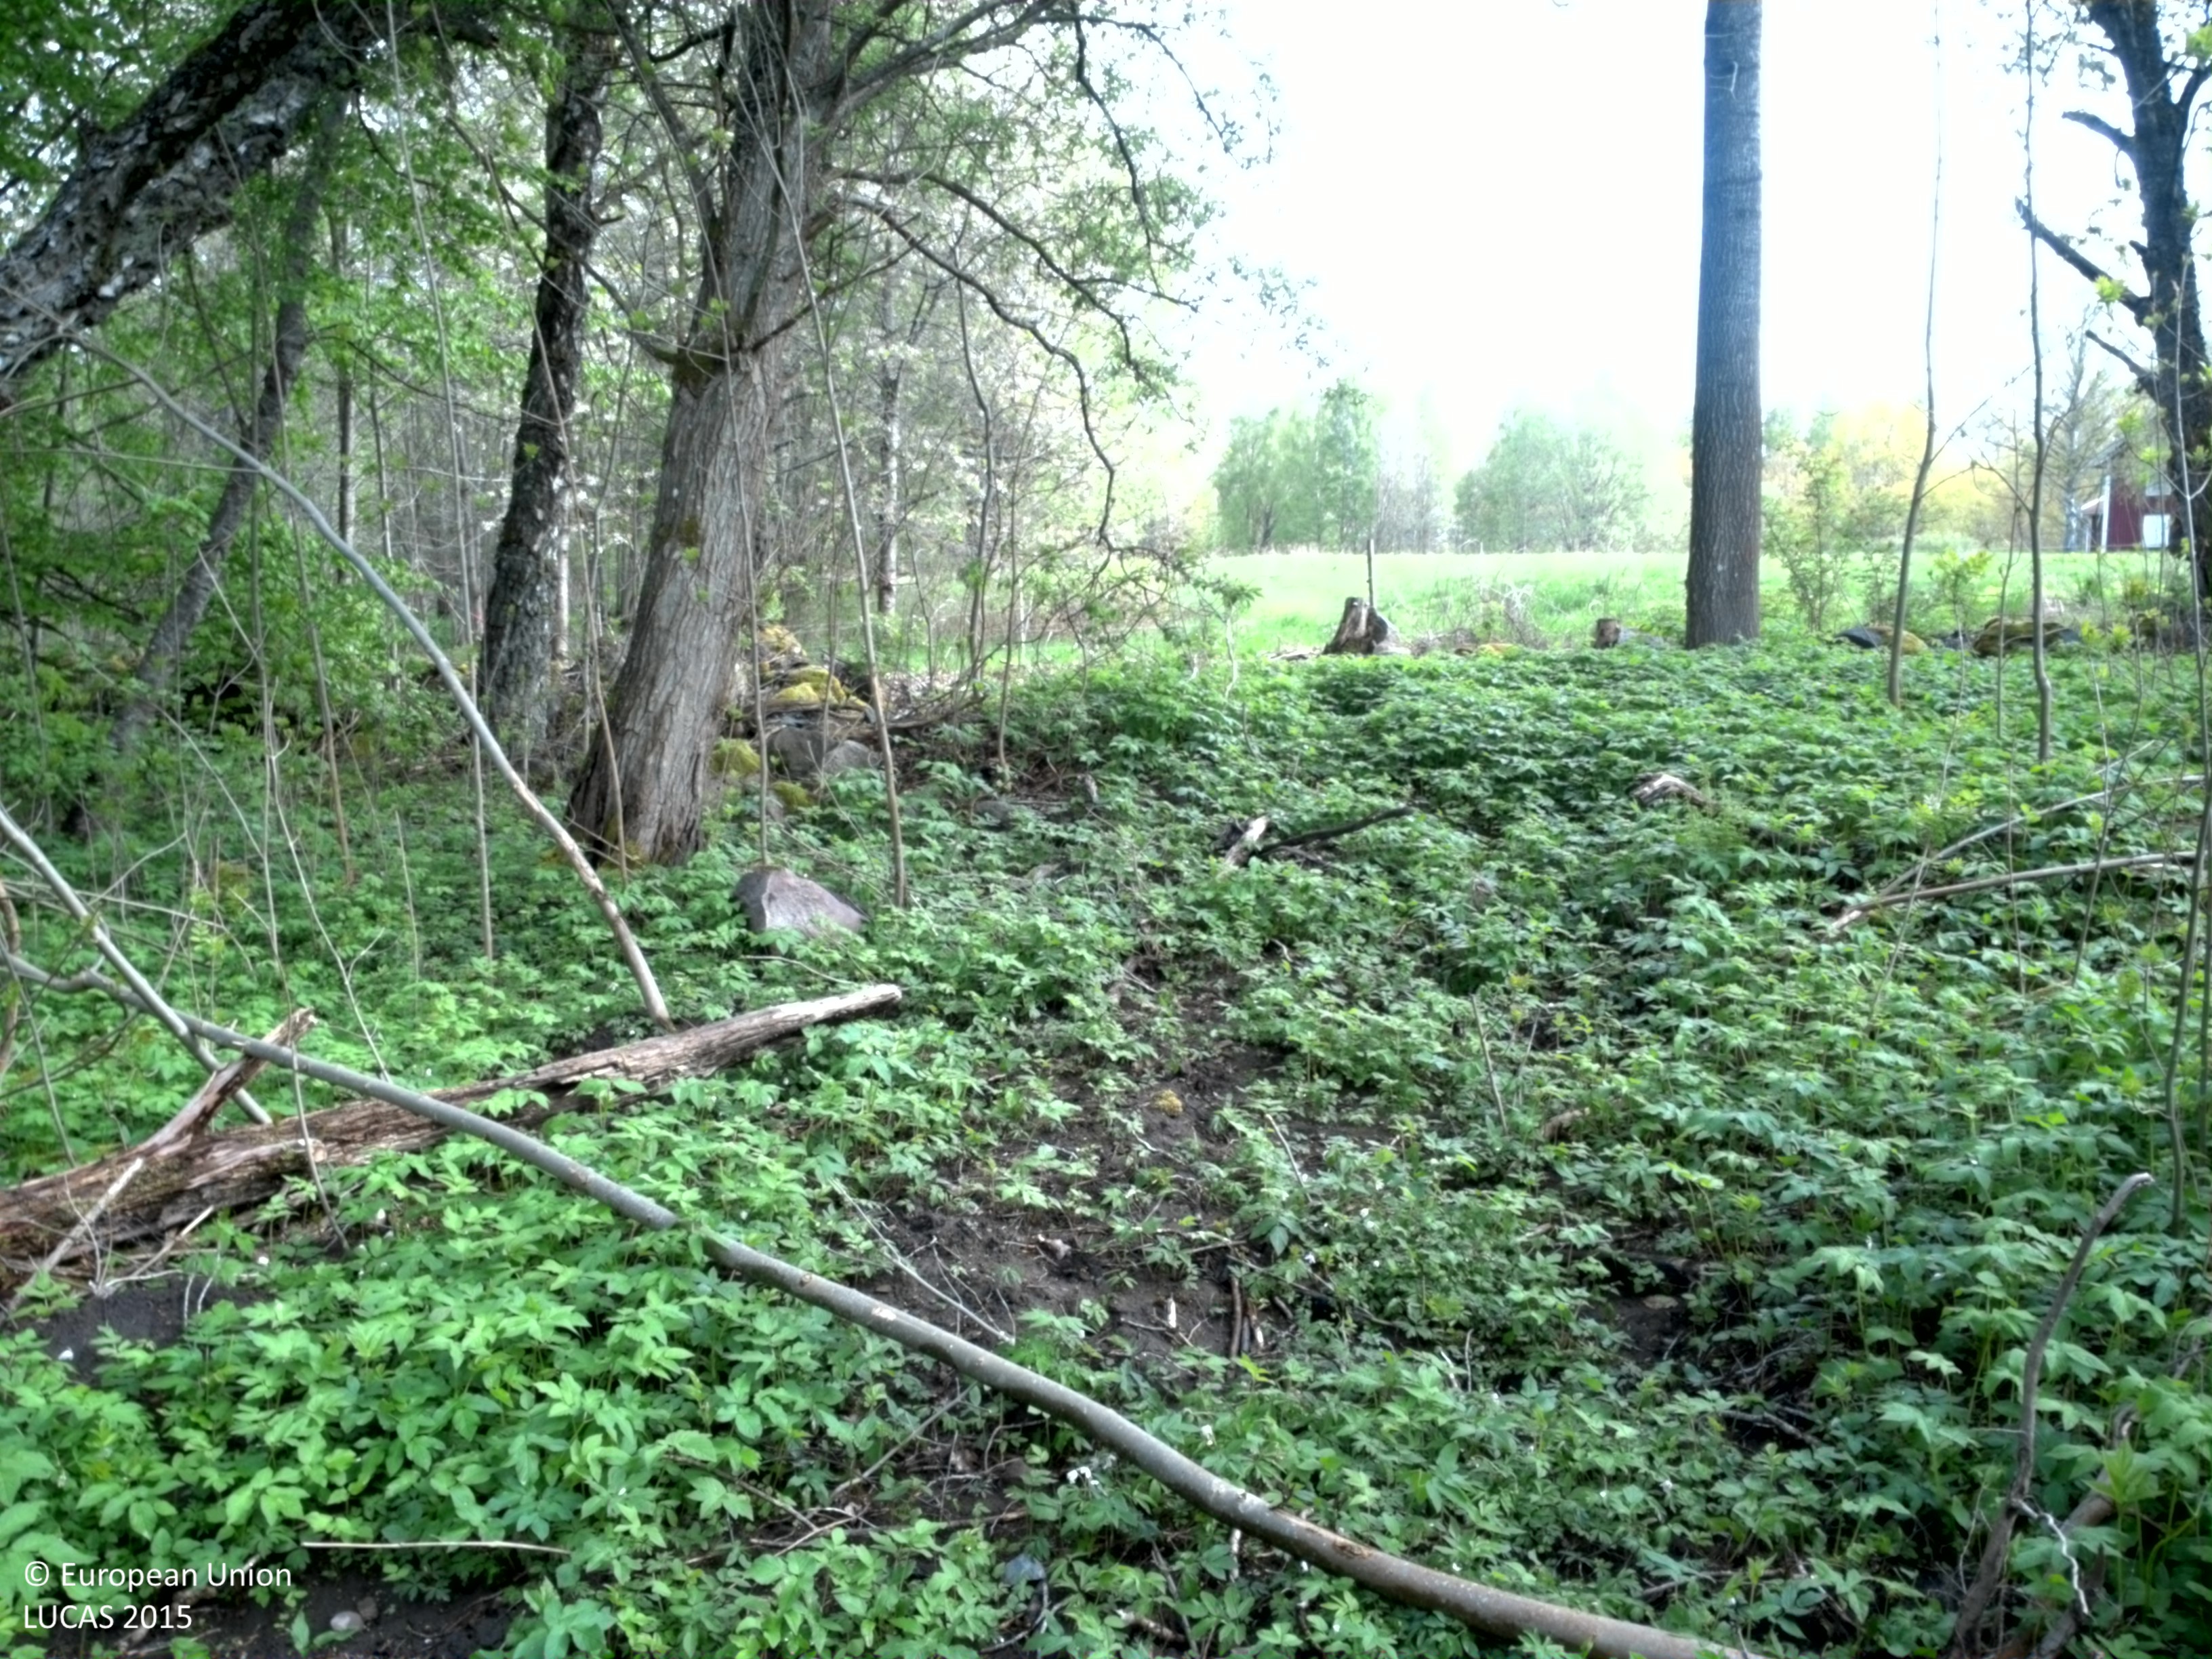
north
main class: Woodland
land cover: Broadleaved woodland
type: boreal forest
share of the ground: 50 - 75 %
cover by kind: broadleaved forest trees 60 %, herbaceous plants 20 %, lichens and mosses 20 %
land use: Amenities, museums, leisure
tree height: > 5 m
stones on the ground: < 10 %
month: May
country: SE
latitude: 56.8545
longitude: 14.8020
